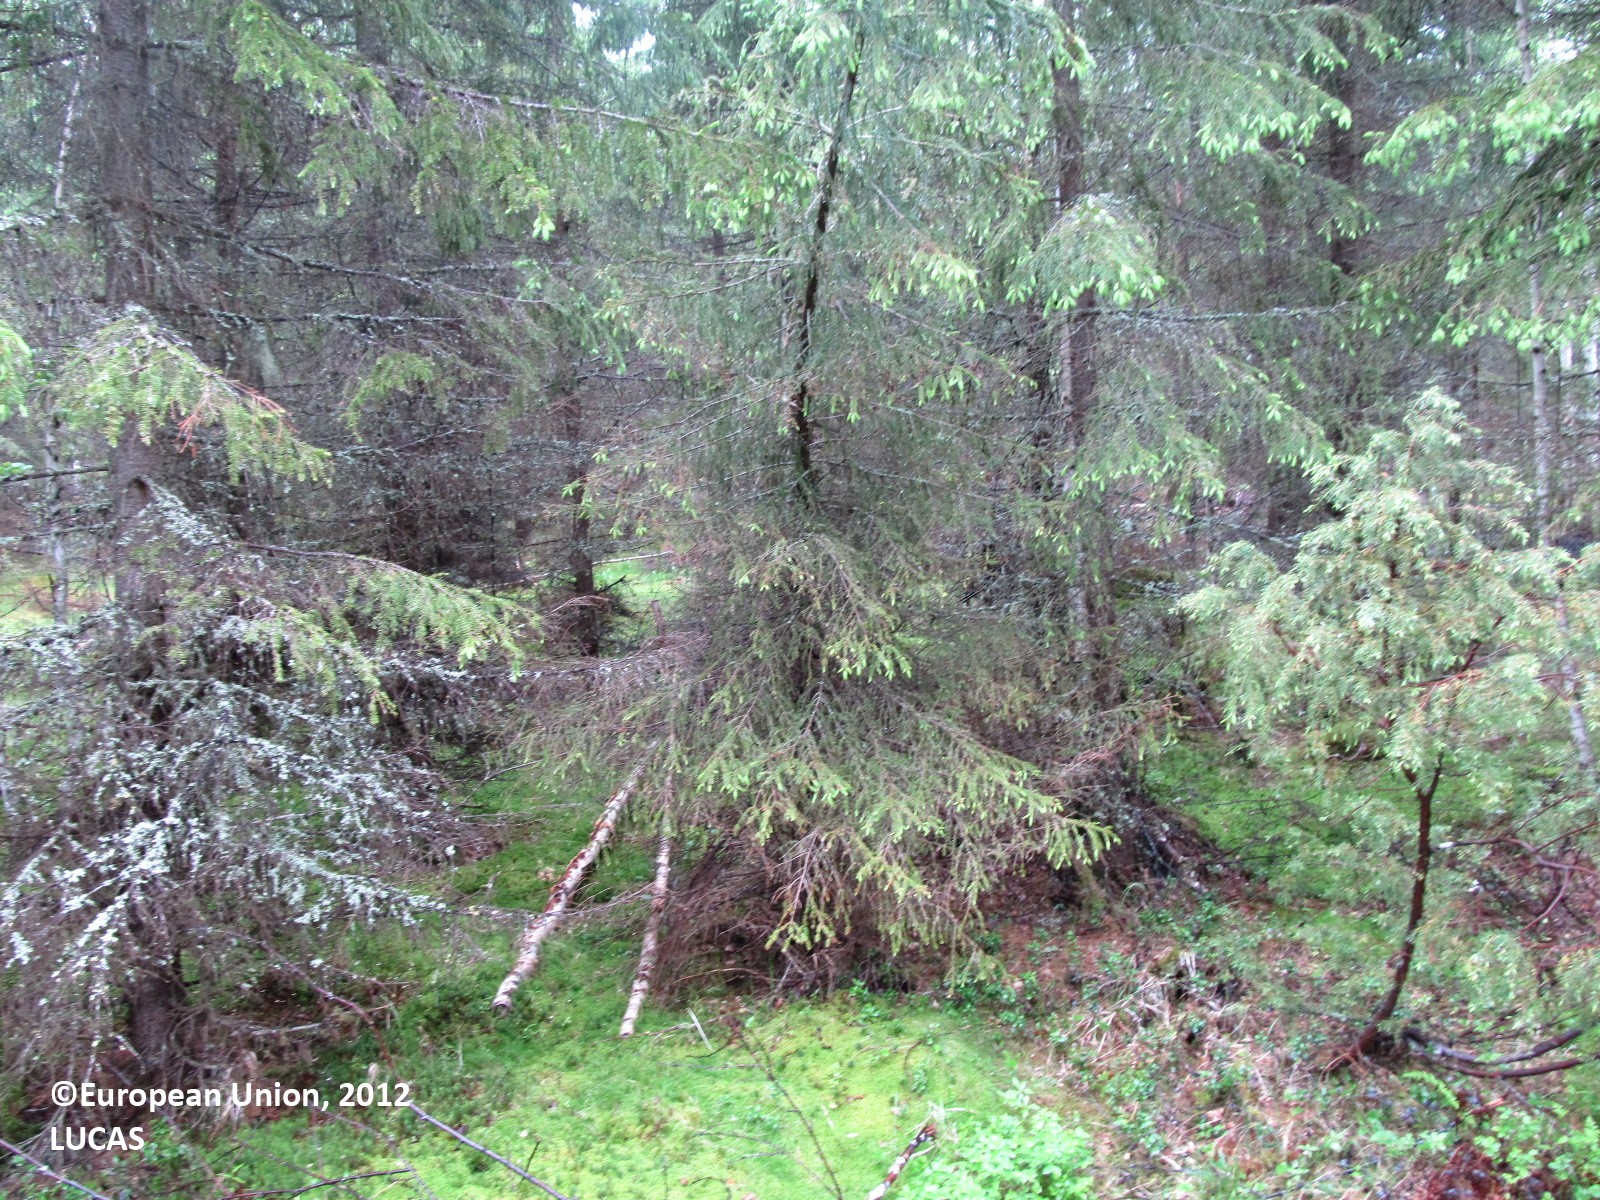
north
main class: Woodland
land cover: Spruce dominated coniferous woodland
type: boreal forest
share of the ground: 25 - 50 %
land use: Forestry
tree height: > 5 m
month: June
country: FI
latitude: 62.8437
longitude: 28.5210
